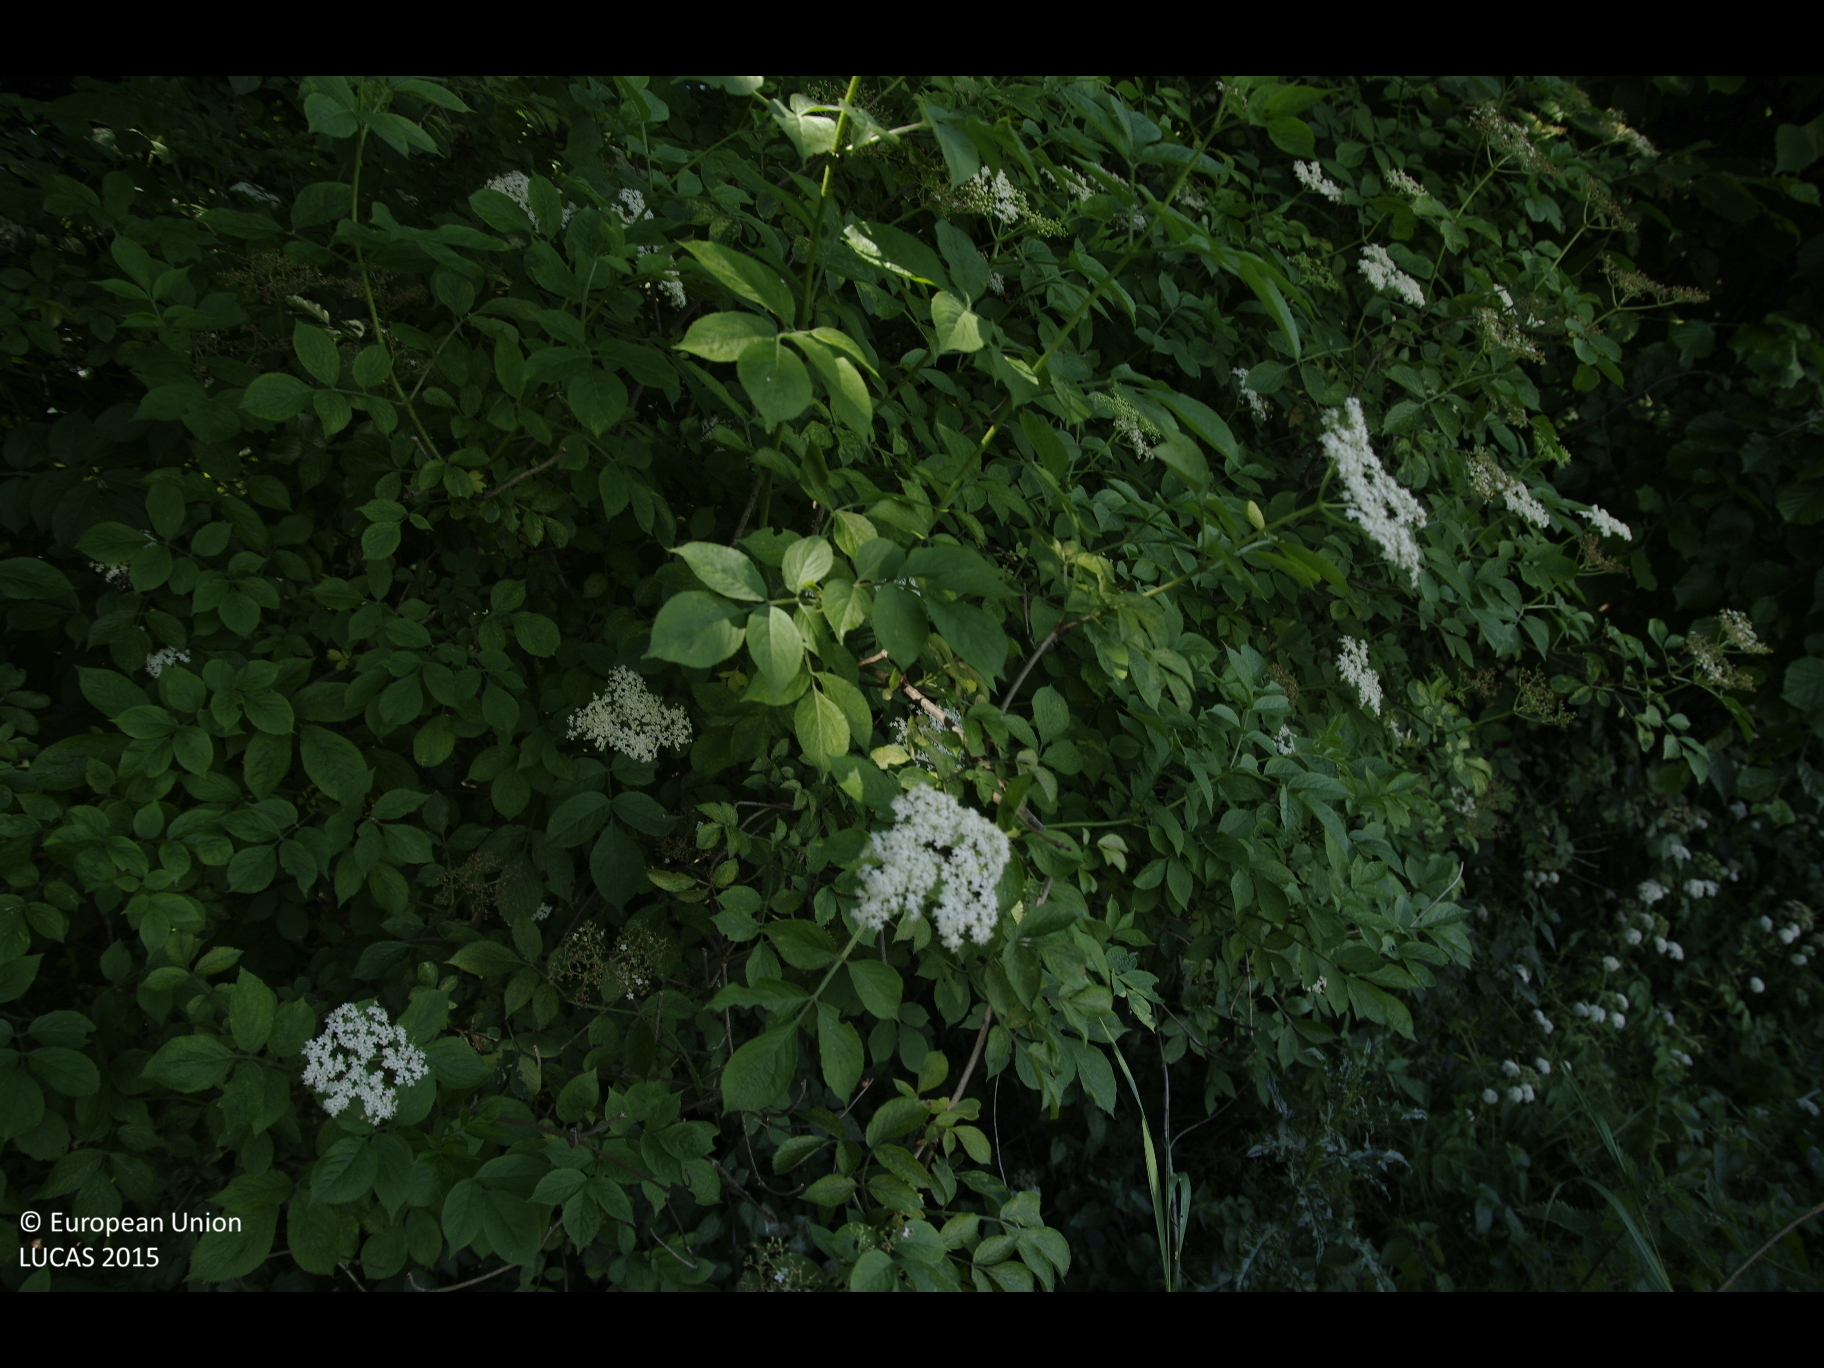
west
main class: Grassland
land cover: Grassland without tree/shrub cover
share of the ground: > 75 %
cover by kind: herbaceous plants 100 %
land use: Agriculture (excluding fallow land and kitchen gardens)
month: June
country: DE
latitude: 53.6699
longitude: 10.6203
